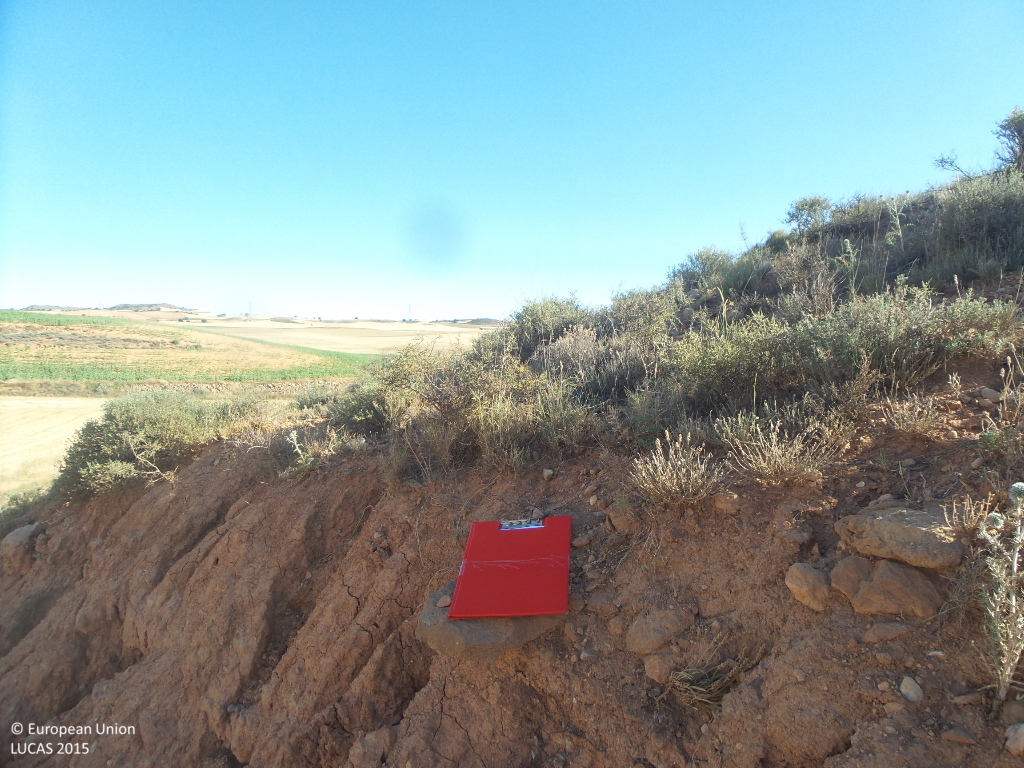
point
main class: Shrubland
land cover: Shrubland without tree cover
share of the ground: 25 - 50 %
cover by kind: unconsolidated bare surface 50 %, shrubs 40 %, herbaceous plants 10 %
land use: Semi-natural and natural areas not in use
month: July
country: ES
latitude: 41.4031
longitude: -2.1962
